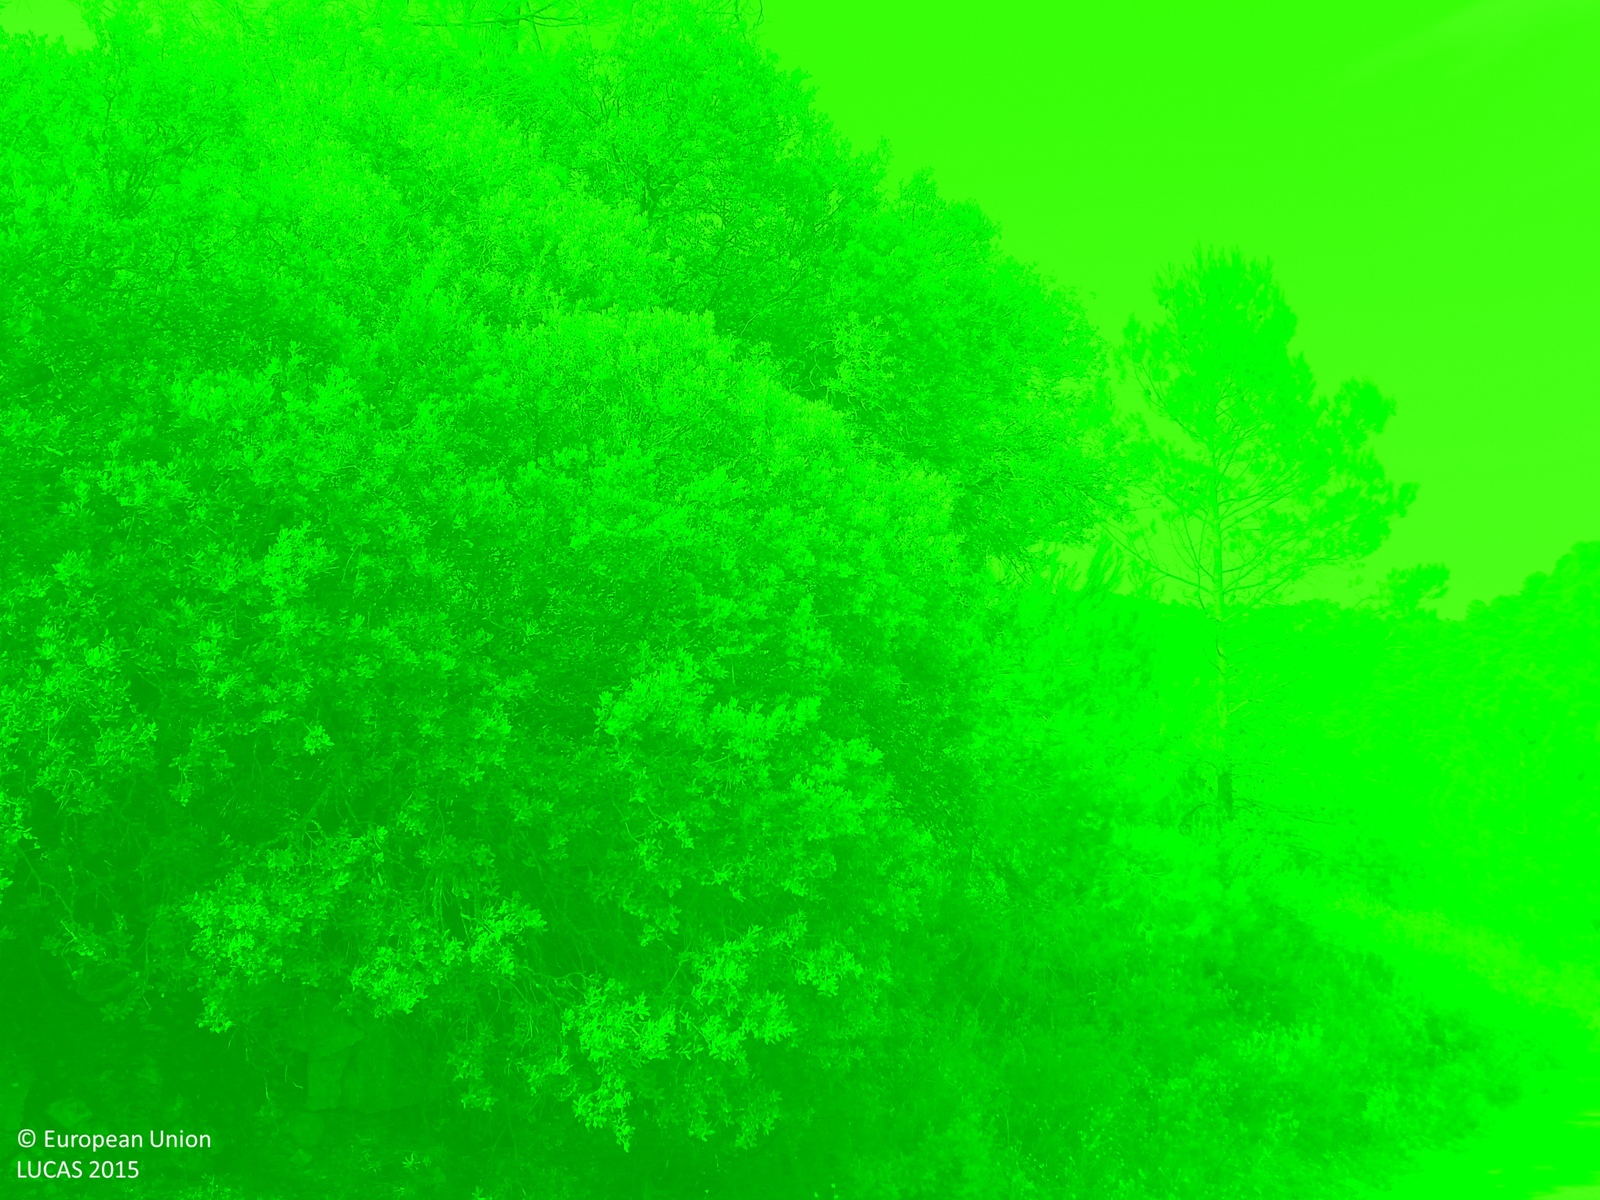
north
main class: Woodland
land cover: Pine dominated coniferous woodland
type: coniferous forest of the mediterranean region
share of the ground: > 75 %
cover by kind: coniferous forest trees 90 %, shrubs 10 %
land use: Semi-natural and natural areas not in use
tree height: > 5 m
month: August
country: ES
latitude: 38.4640
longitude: -2.5946
